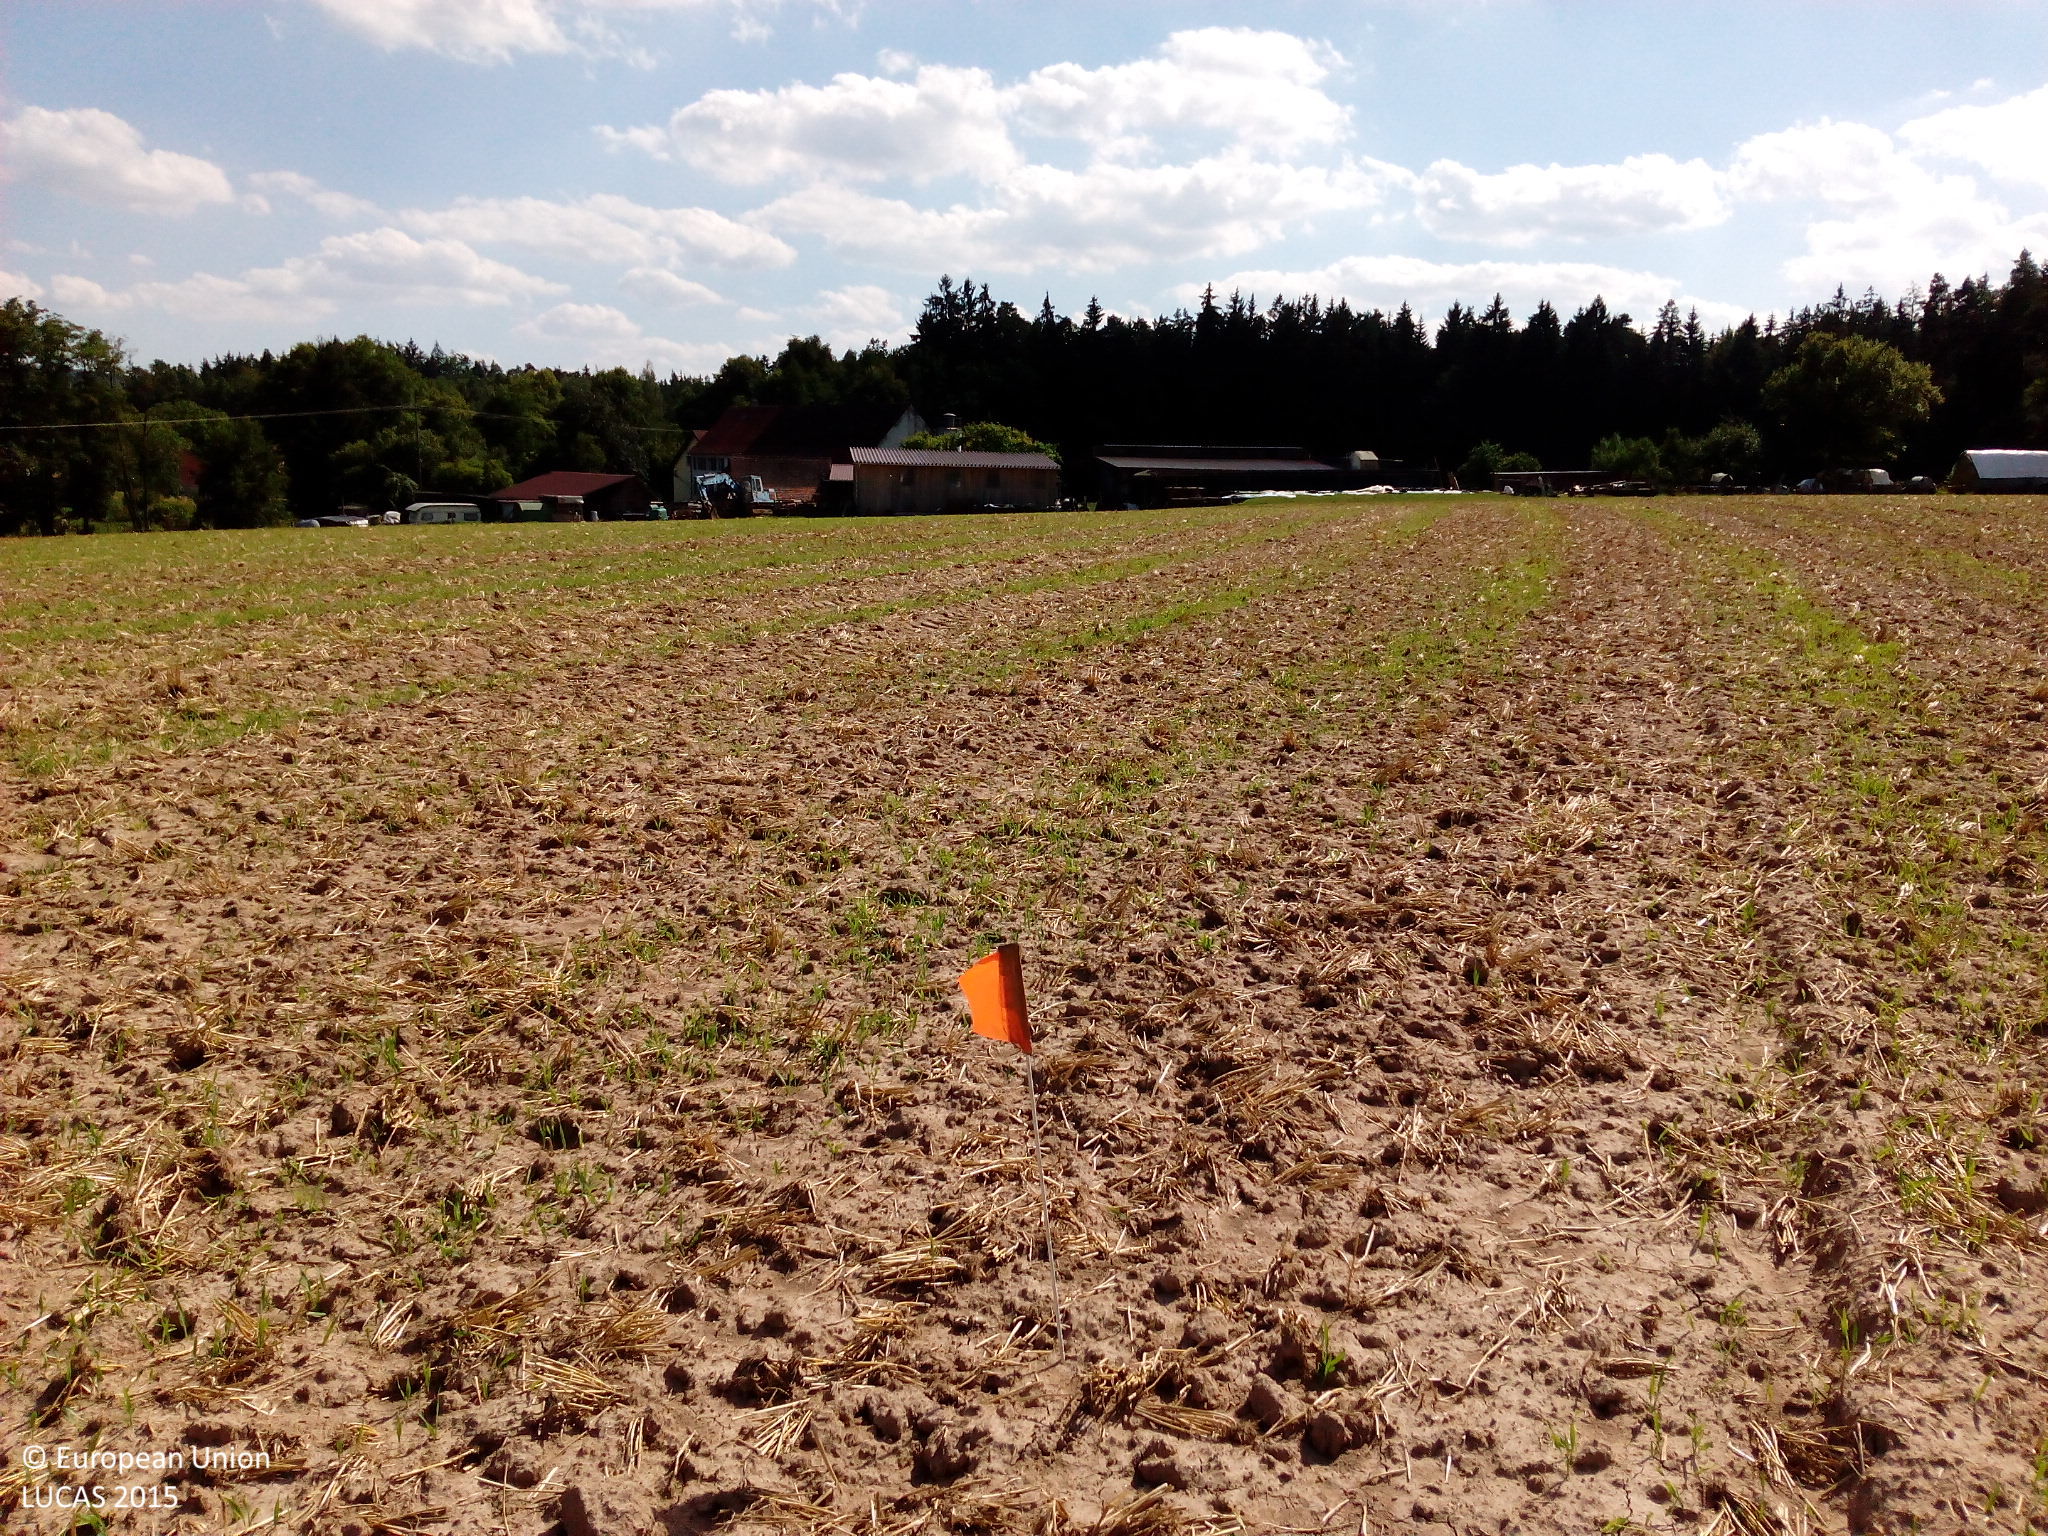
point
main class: Cropland
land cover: Common wheat
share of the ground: < 10 %
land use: Agriculture (excluding fallow land and kitchen gardens)
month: August
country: DE
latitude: 49.0147
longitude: 10.3143
